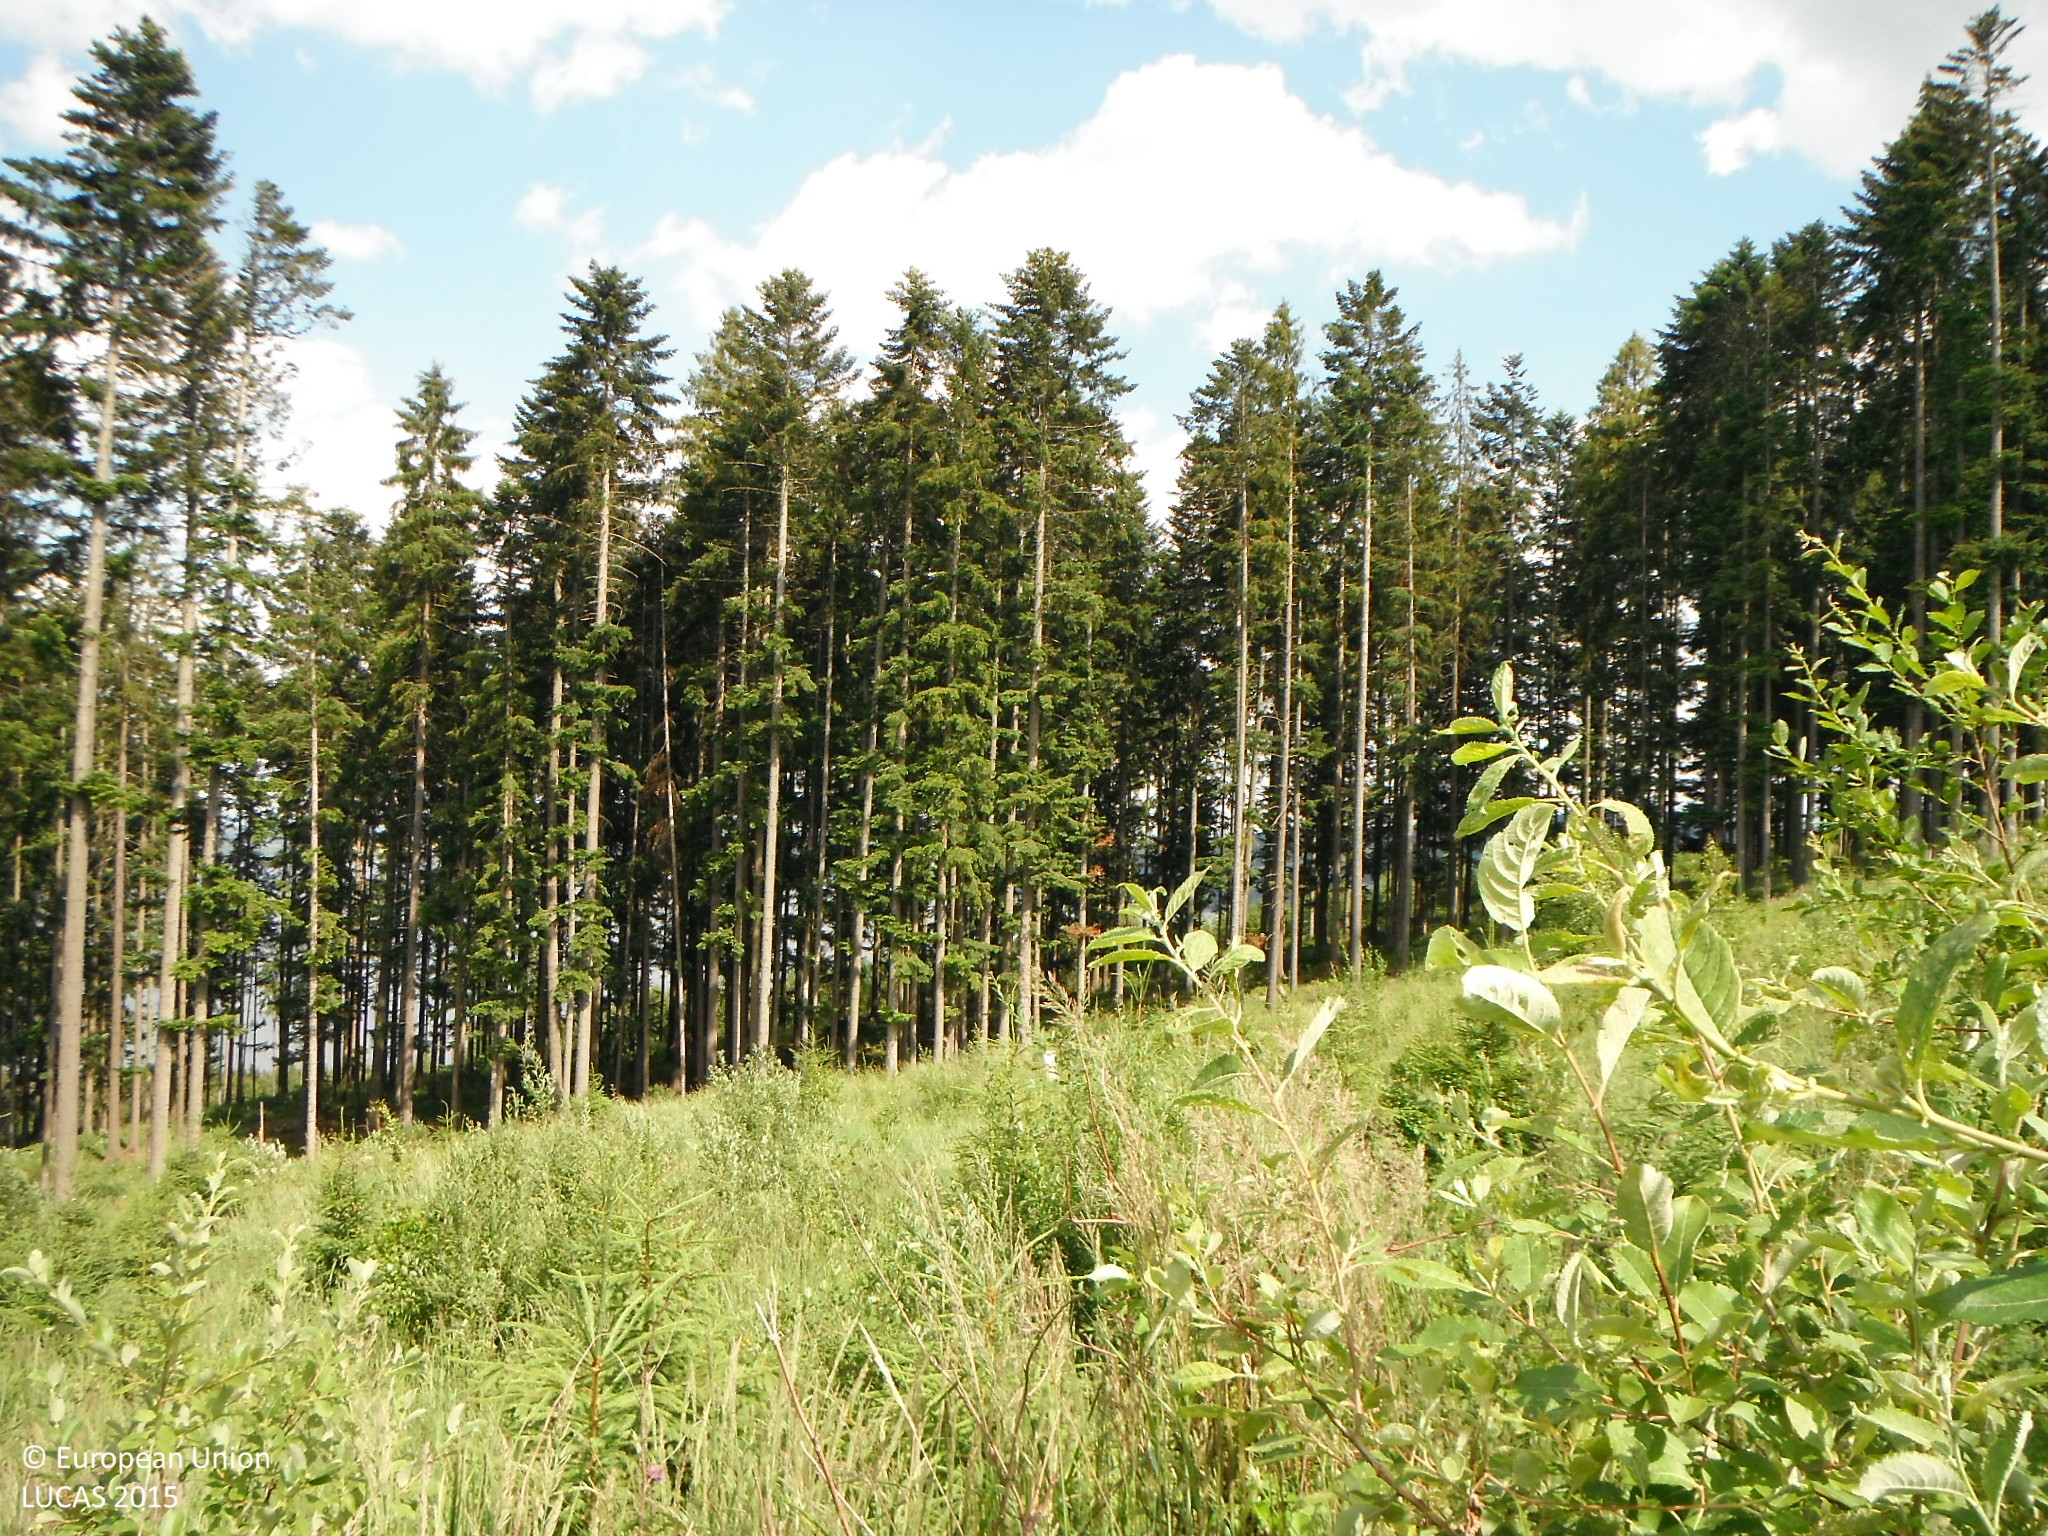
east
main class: Shrubland
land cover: Shrubland without tree cover
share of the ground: > 75 %
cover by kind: shrubs 80 %, herbaceous plants 20 %
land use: Forestry
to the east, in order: Shrubland without tree cover; Spontaneously vegetated surfaces; Other coniferous woodland; Tracks; Other coniferous woodland; Spruce dominated mixed woodland; Spruce dominated coniferous woodland
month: July
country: SK
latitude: 49.3868
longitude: 19.5185
